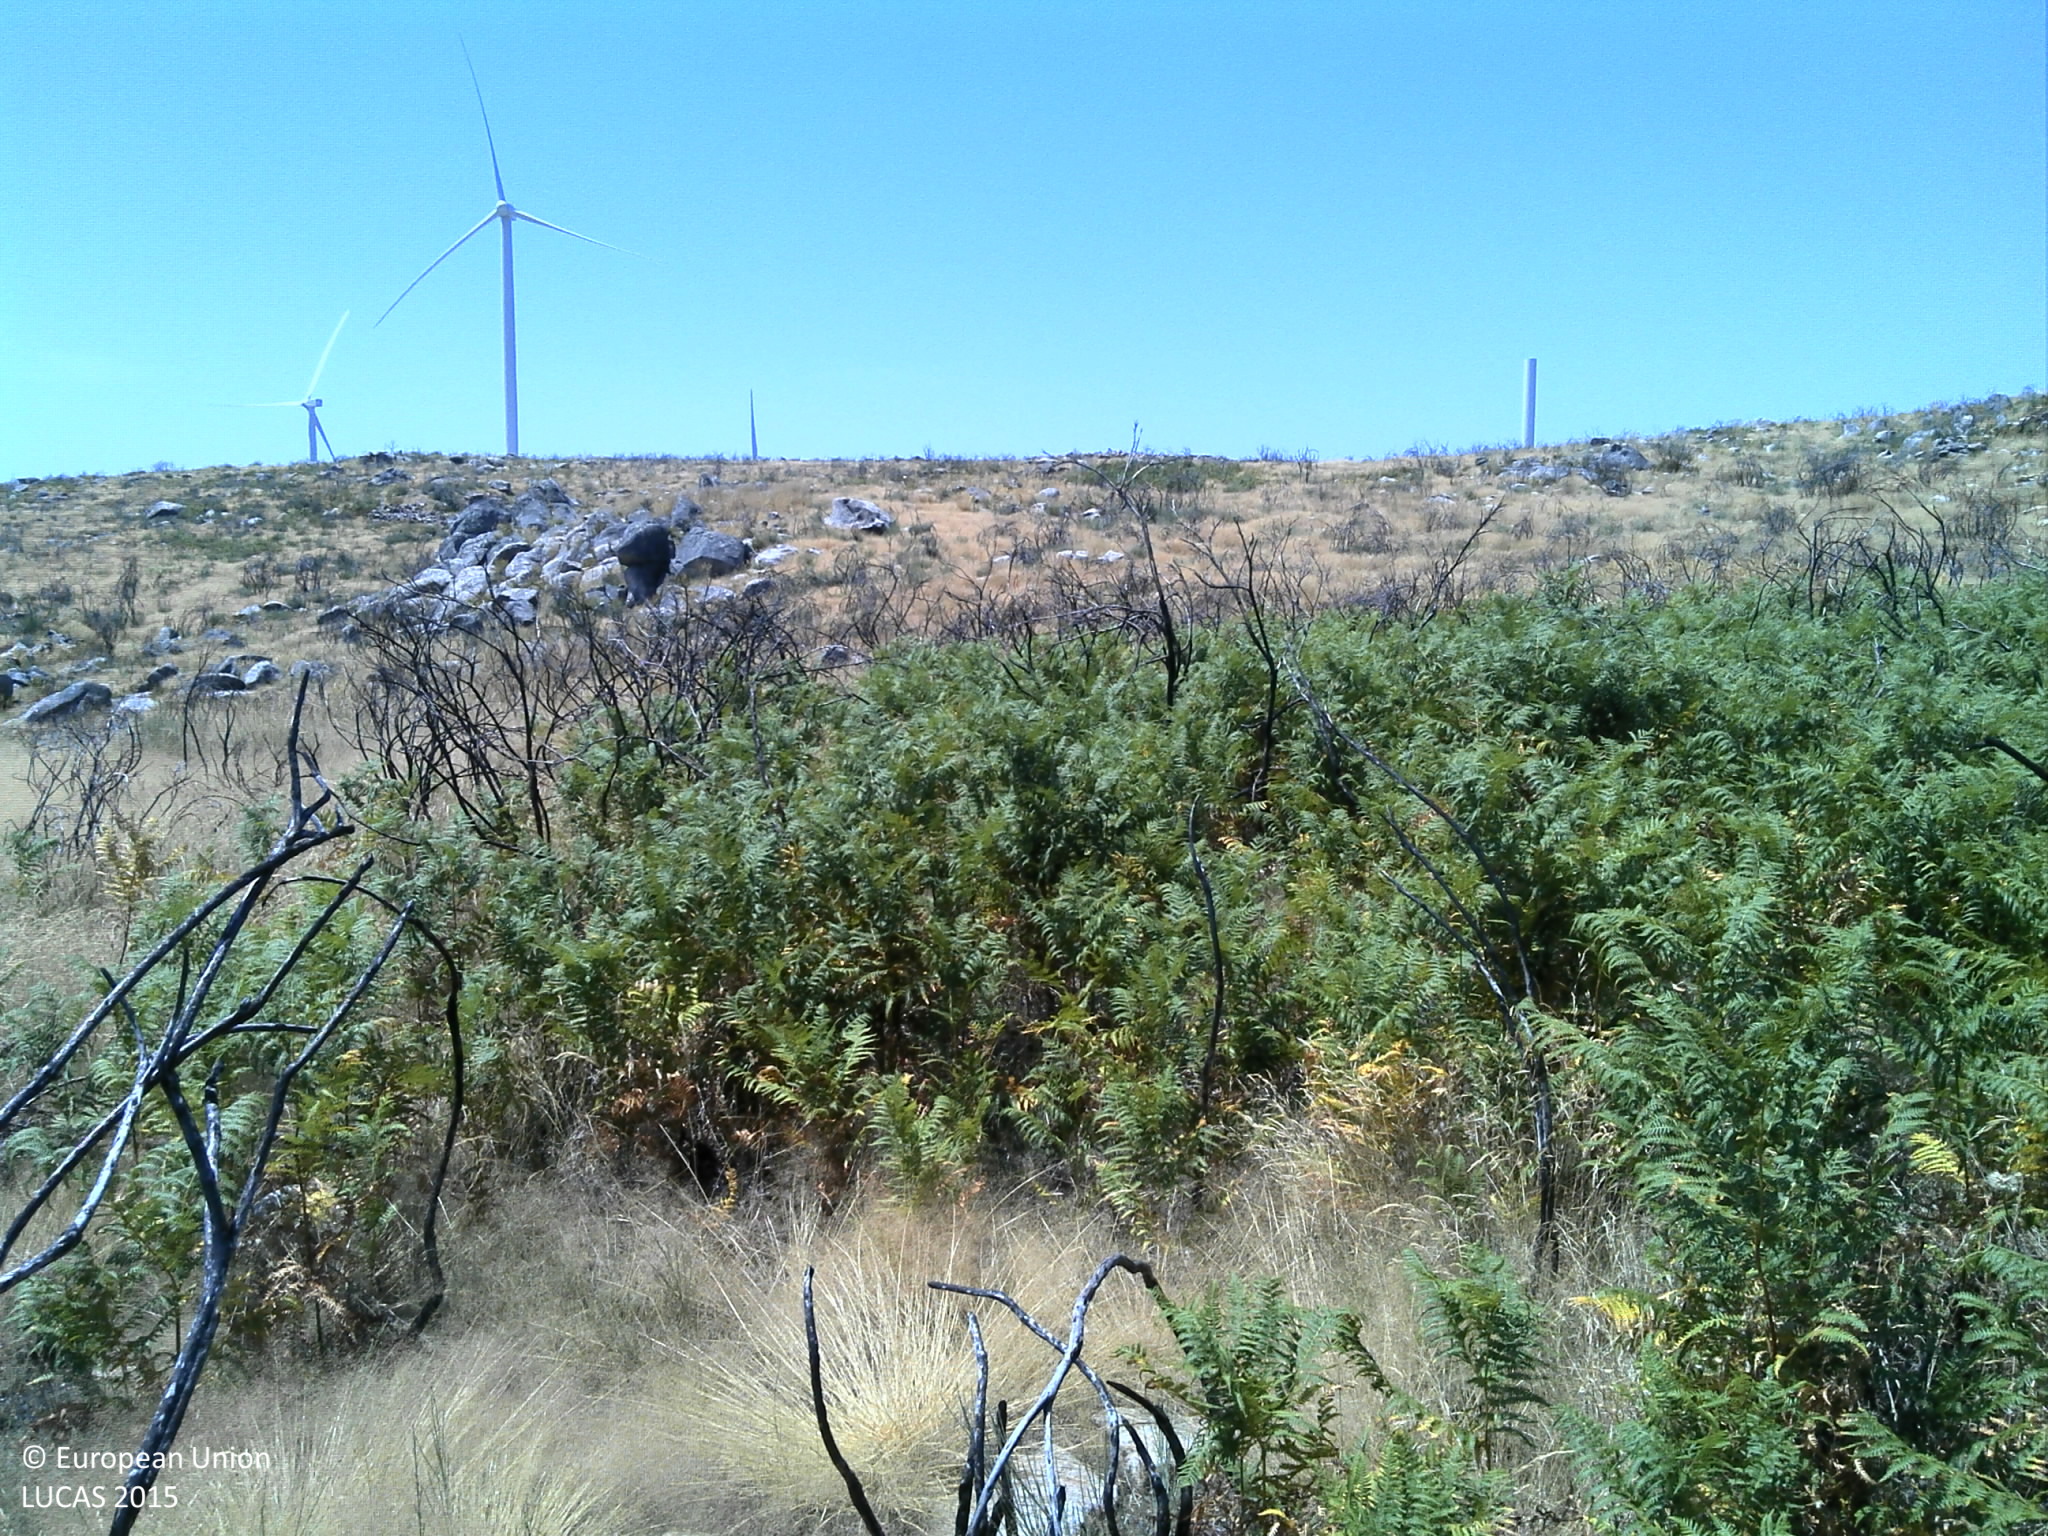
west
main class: Grassland
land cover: Grassland without tree/shrub cover
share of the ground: 50 - 75 %
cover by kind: herbaceous plants 60 %, consolidated bare surface 20 %, unconsolidated bare surface 15 %, shrubs 5 %
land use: Semi-natural and natural areas not in use
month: July
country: PT
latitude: 40.8754
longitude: -7.4038
